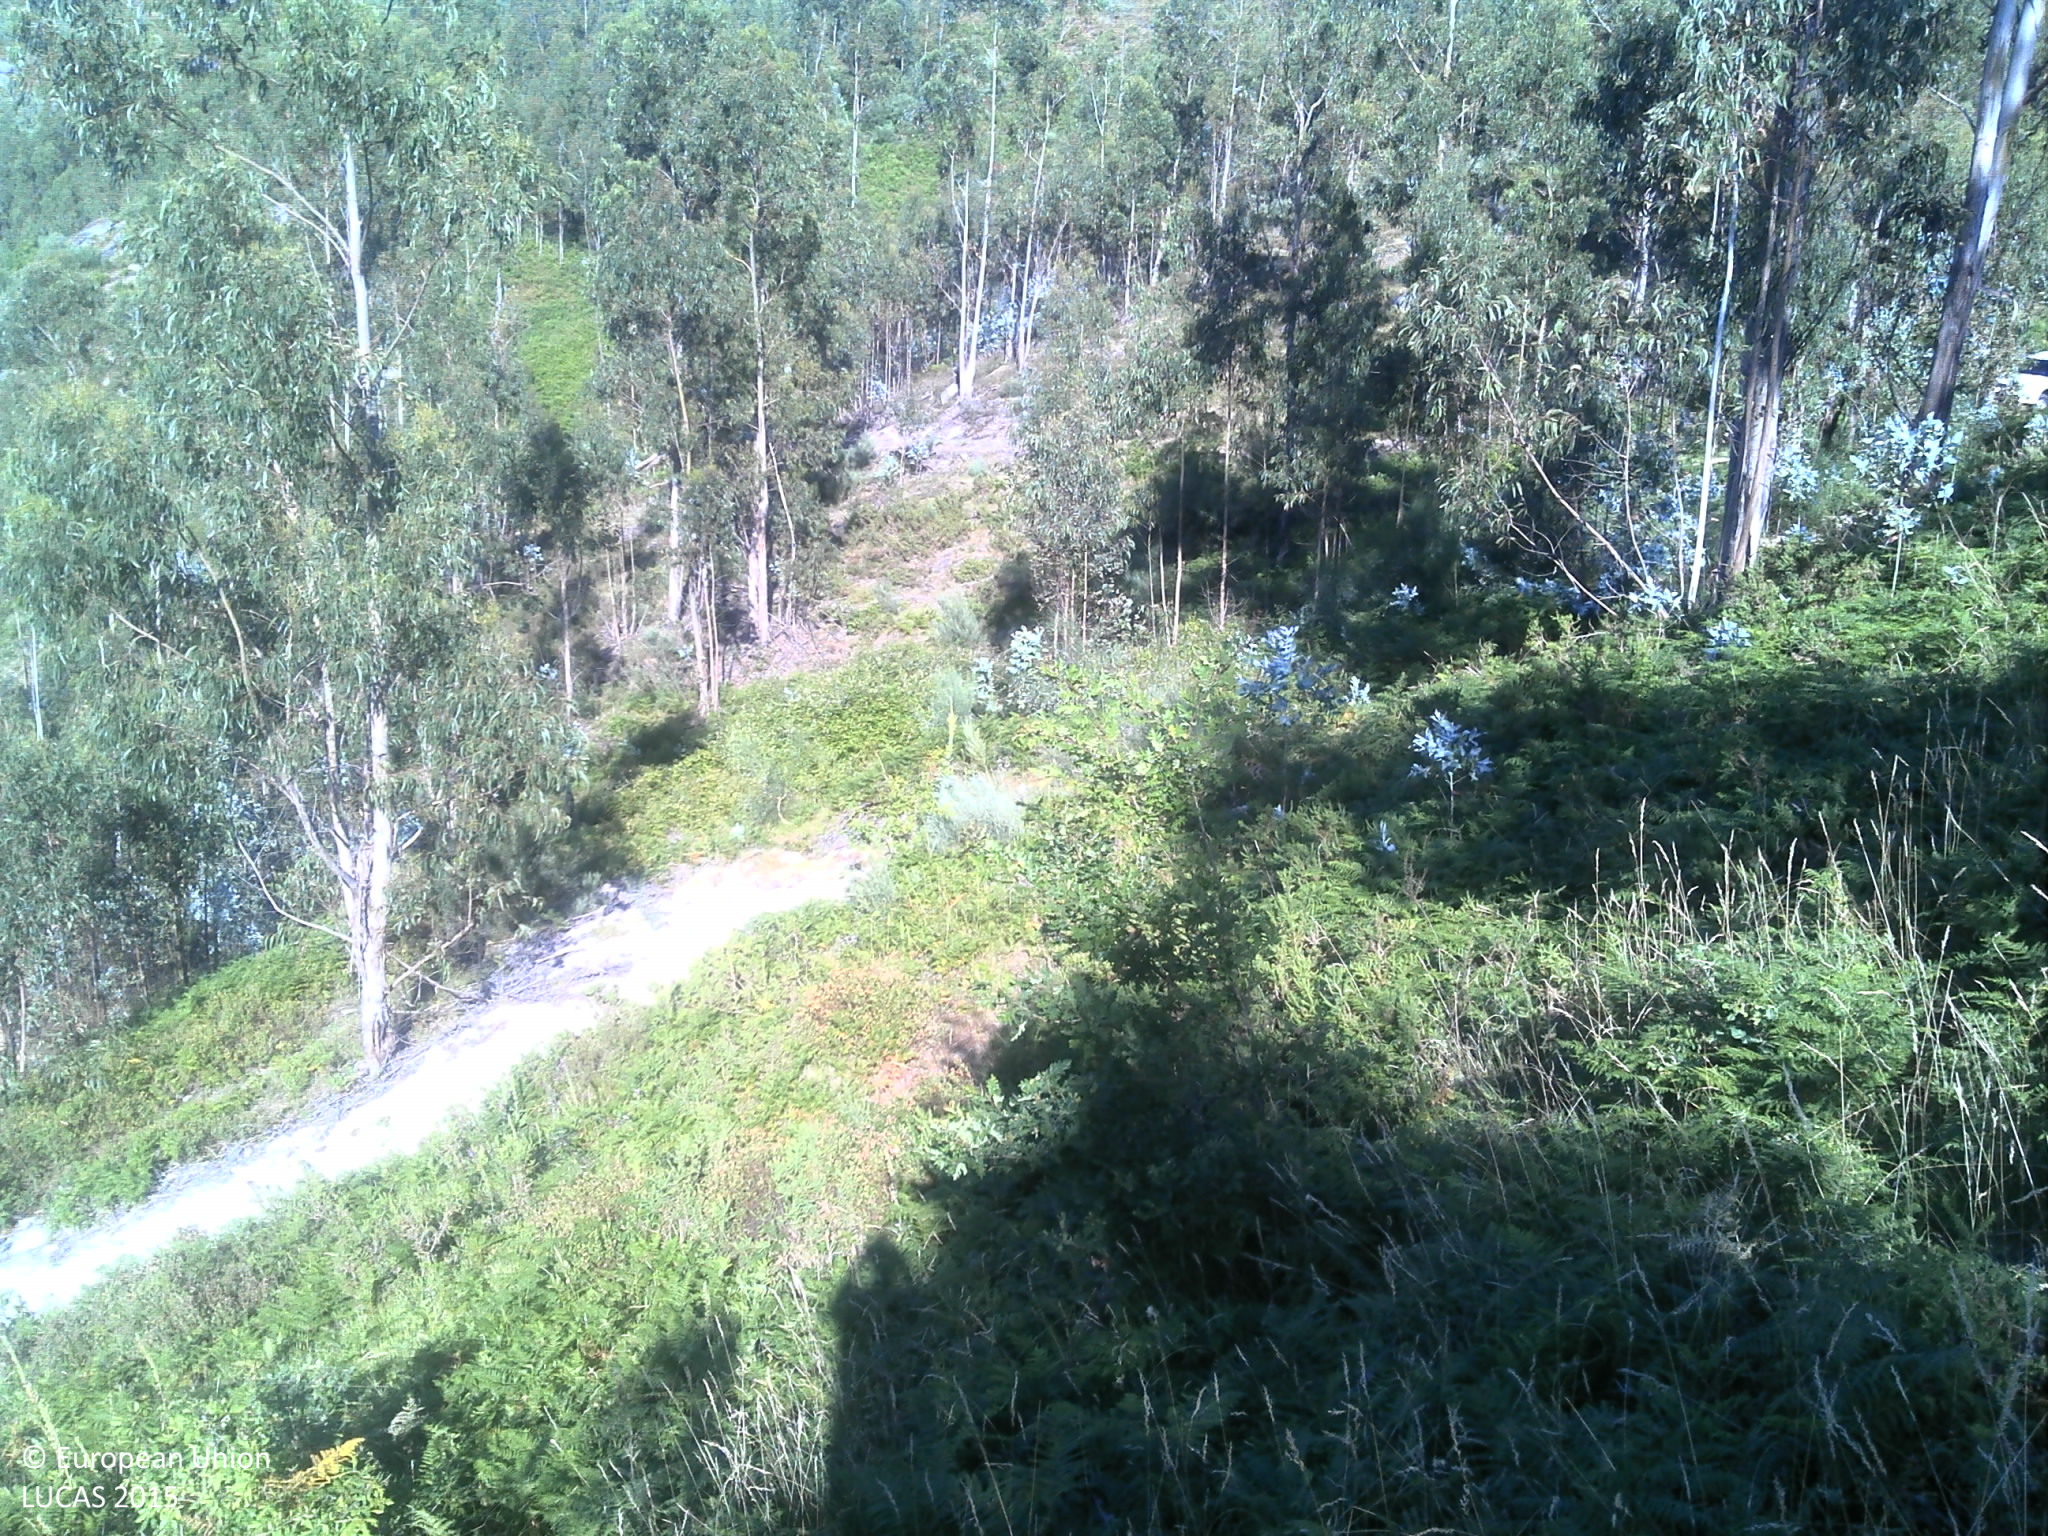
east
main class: Shrubland
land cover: Shrubland with sparse tree cover
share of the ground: > 75 %
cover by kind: shrubs 85 %, broadleaved forest trees 5 %, herbaceous plants 5 %, unconsolidated bare surface 5 %
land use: Agriculture (excluding fallow land and kitchen gardens)
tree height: < 5 m
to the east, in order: Shrubland with sparse tree cover; Tracks; Shrubland without tree cover; Broadleaved woodland; Shrubland without tree cover; Broadleaved woodland; Tracks; Shrubland without tree cover
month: June
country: PT
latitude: 41.5491
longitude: -8.1650
